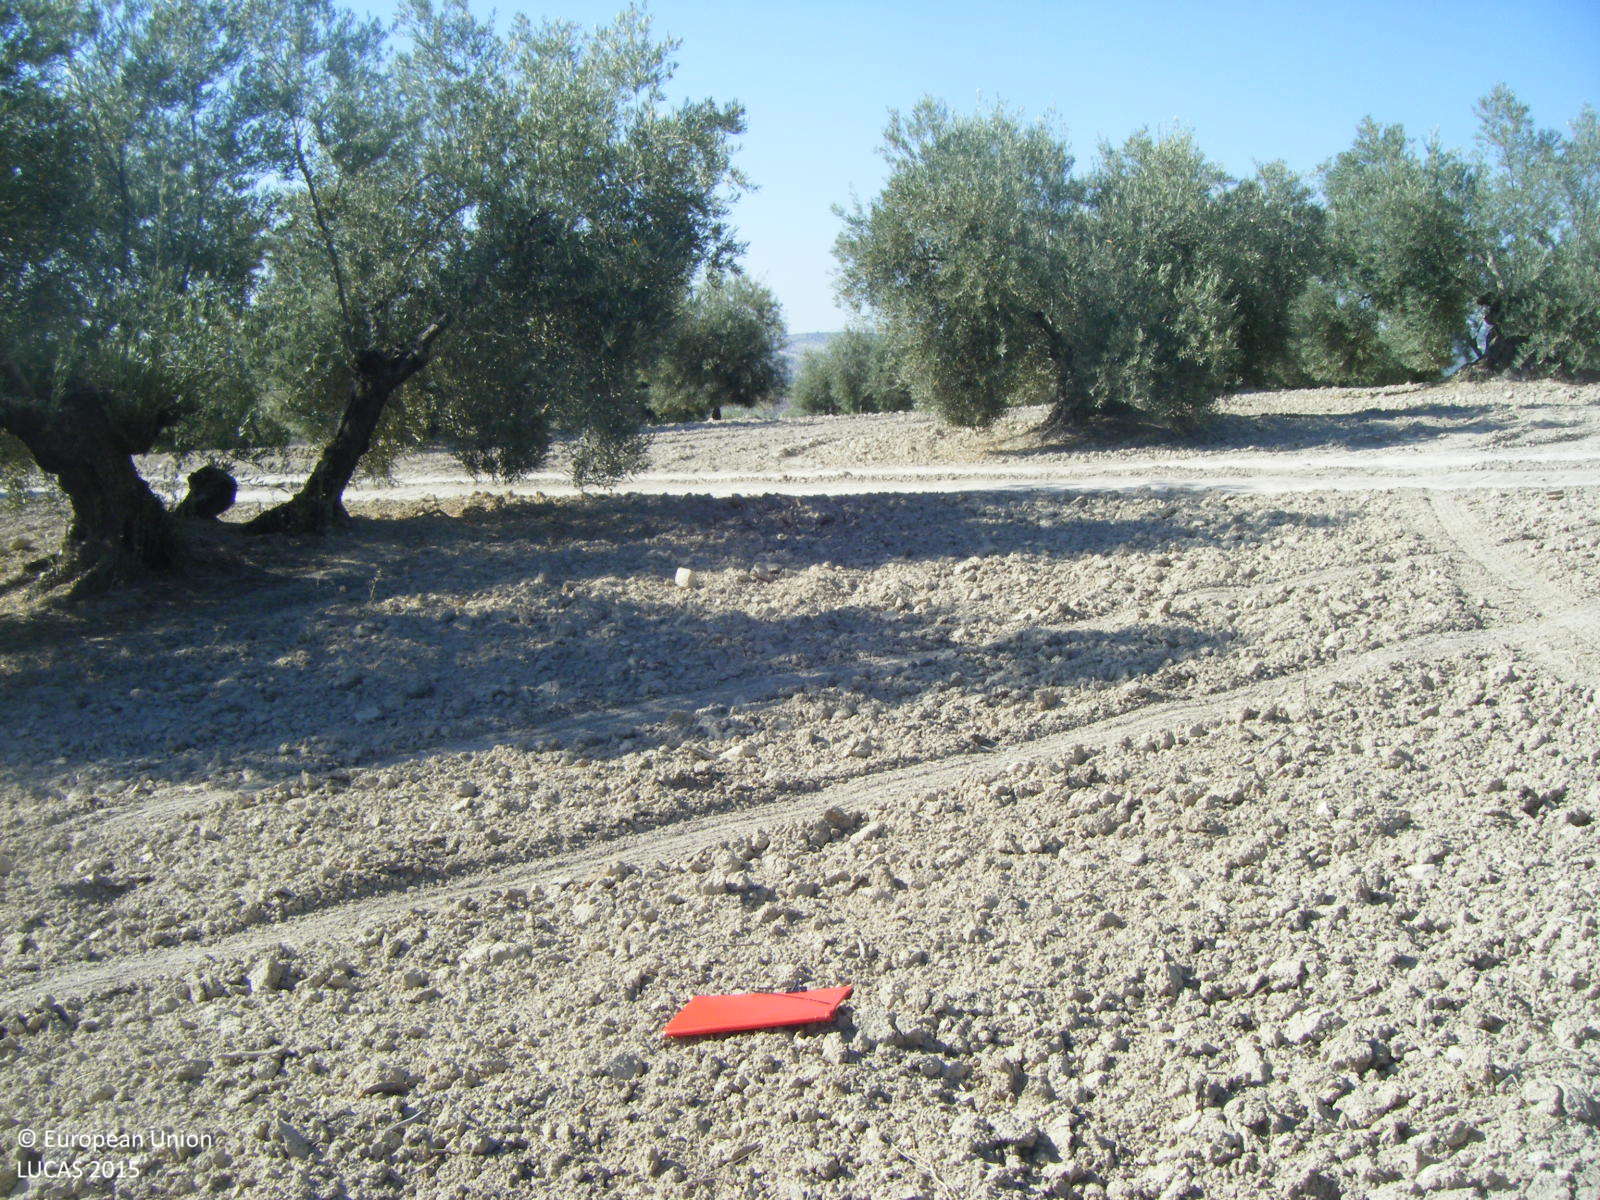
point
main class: Cropland
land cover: Olive groves
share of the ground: 10 - 25 %
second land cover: Other bare soil
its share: > 75 %
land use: Agriculture (excluding fallow land and kitchen gardens)
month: June
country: ES
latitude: 37.2890
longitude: -4.5181
